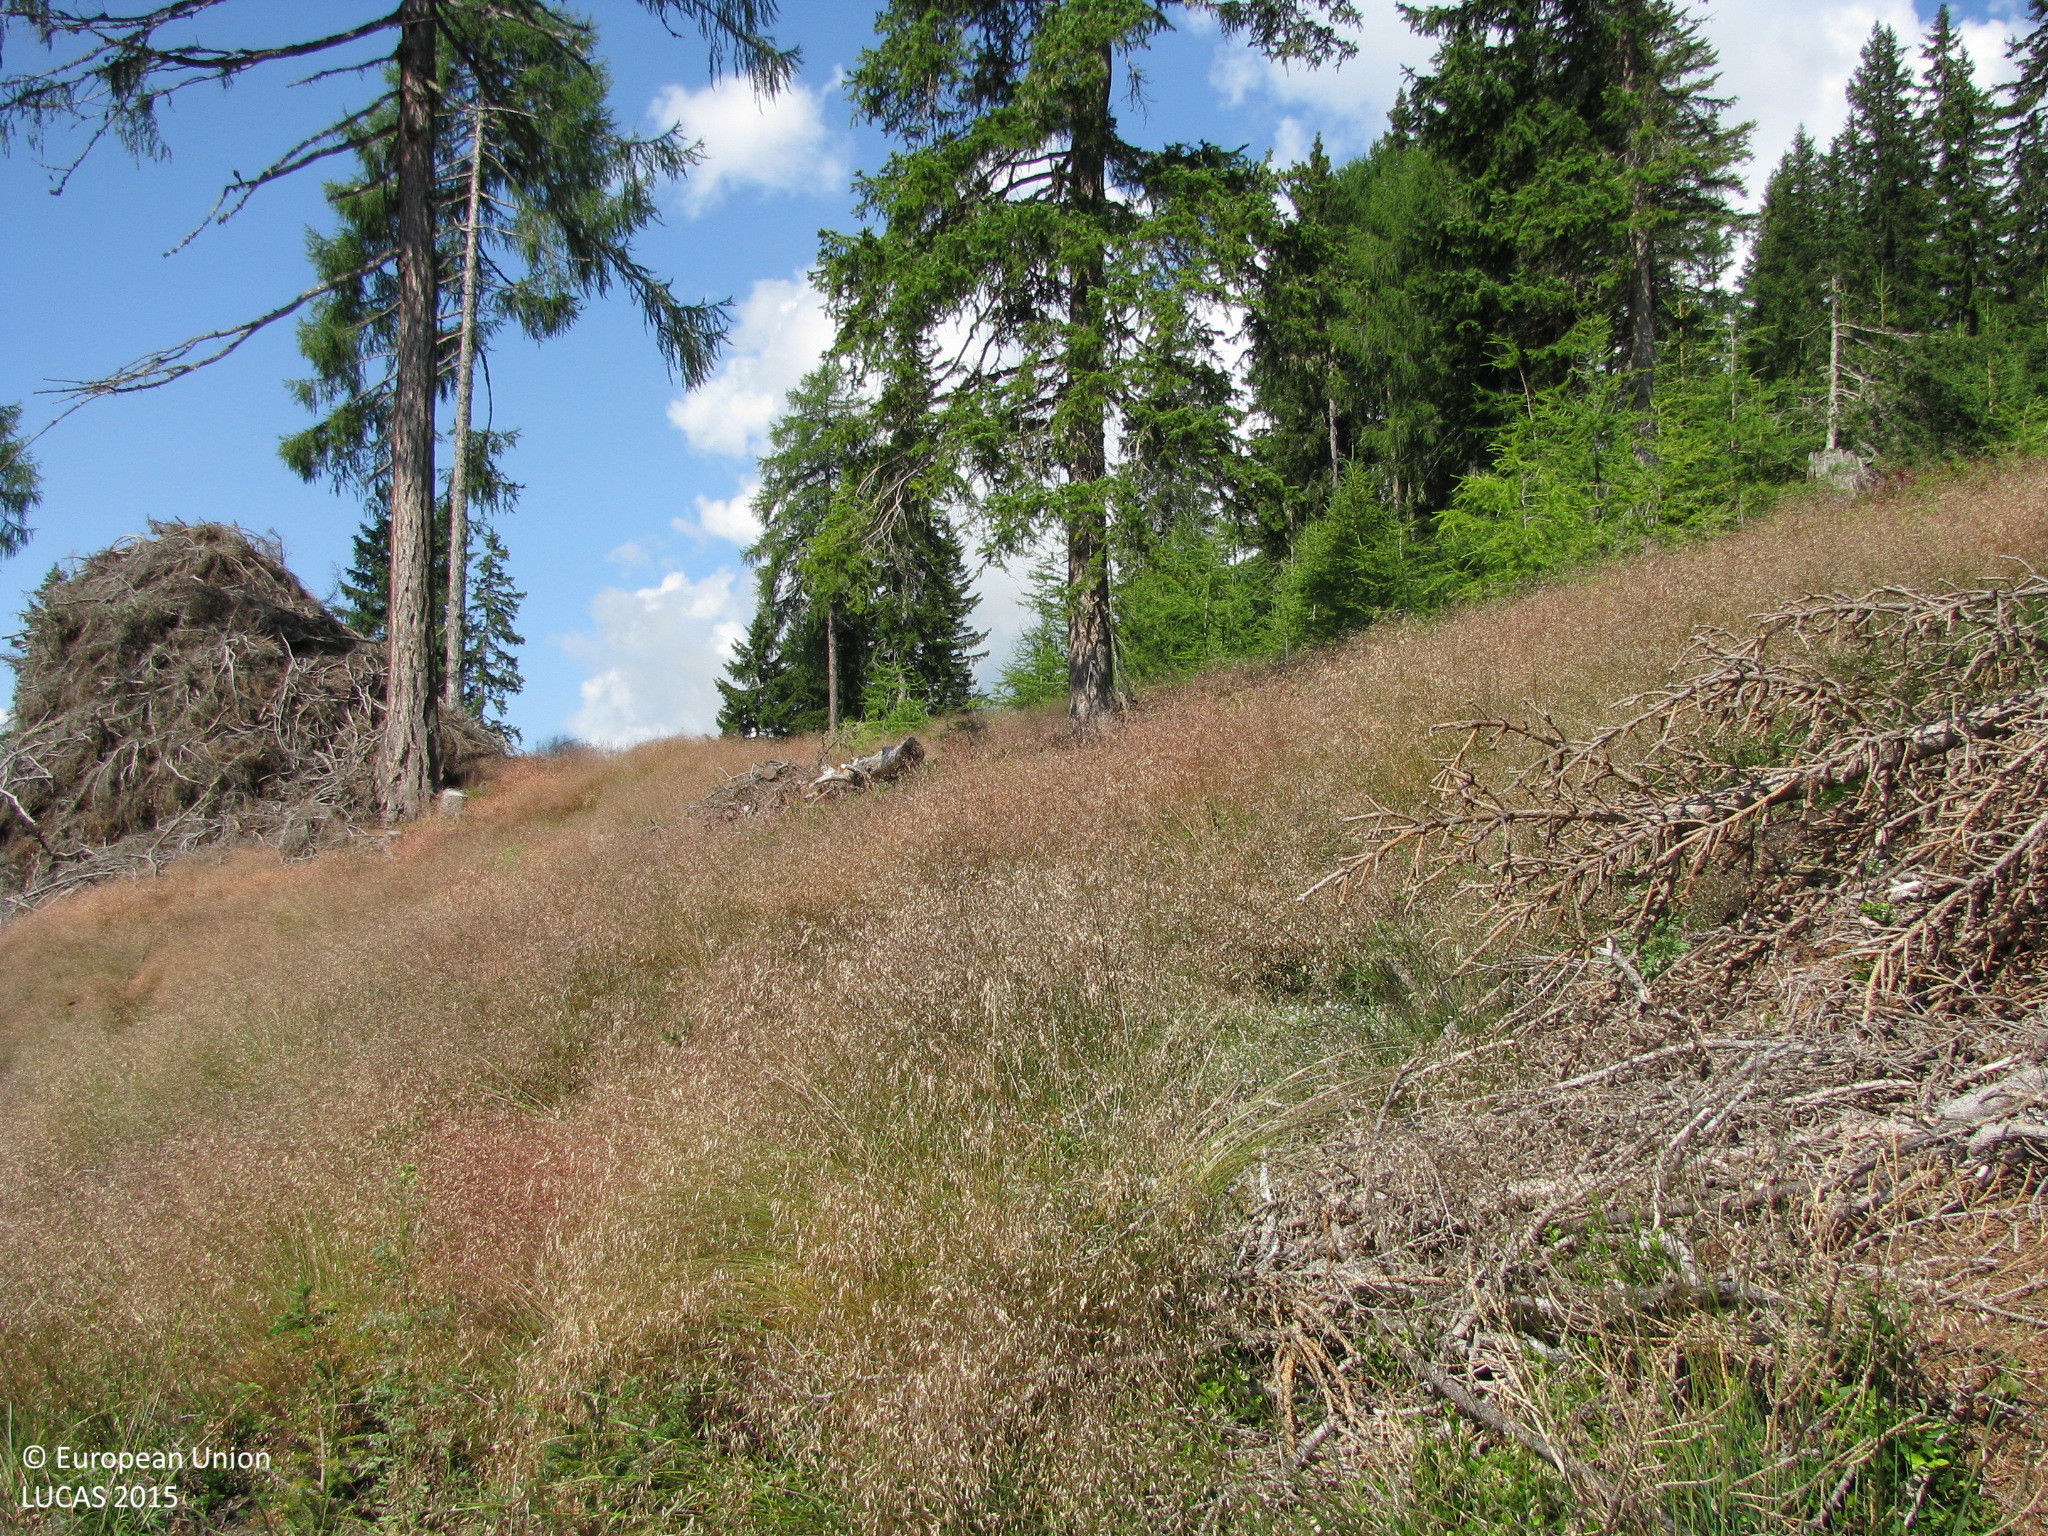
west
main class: Grassland
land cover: Grassland with sparse tree/shrub cover
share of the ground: > 75 %
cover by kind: herbaceous plants 90 %, coniferous forest trees 5 %, unconsolidated bare surface 5 %
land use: Forestry
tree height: > 5 m
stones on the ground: < 10 %
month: July
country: AT
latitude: 46.8047
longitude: 12.6576
